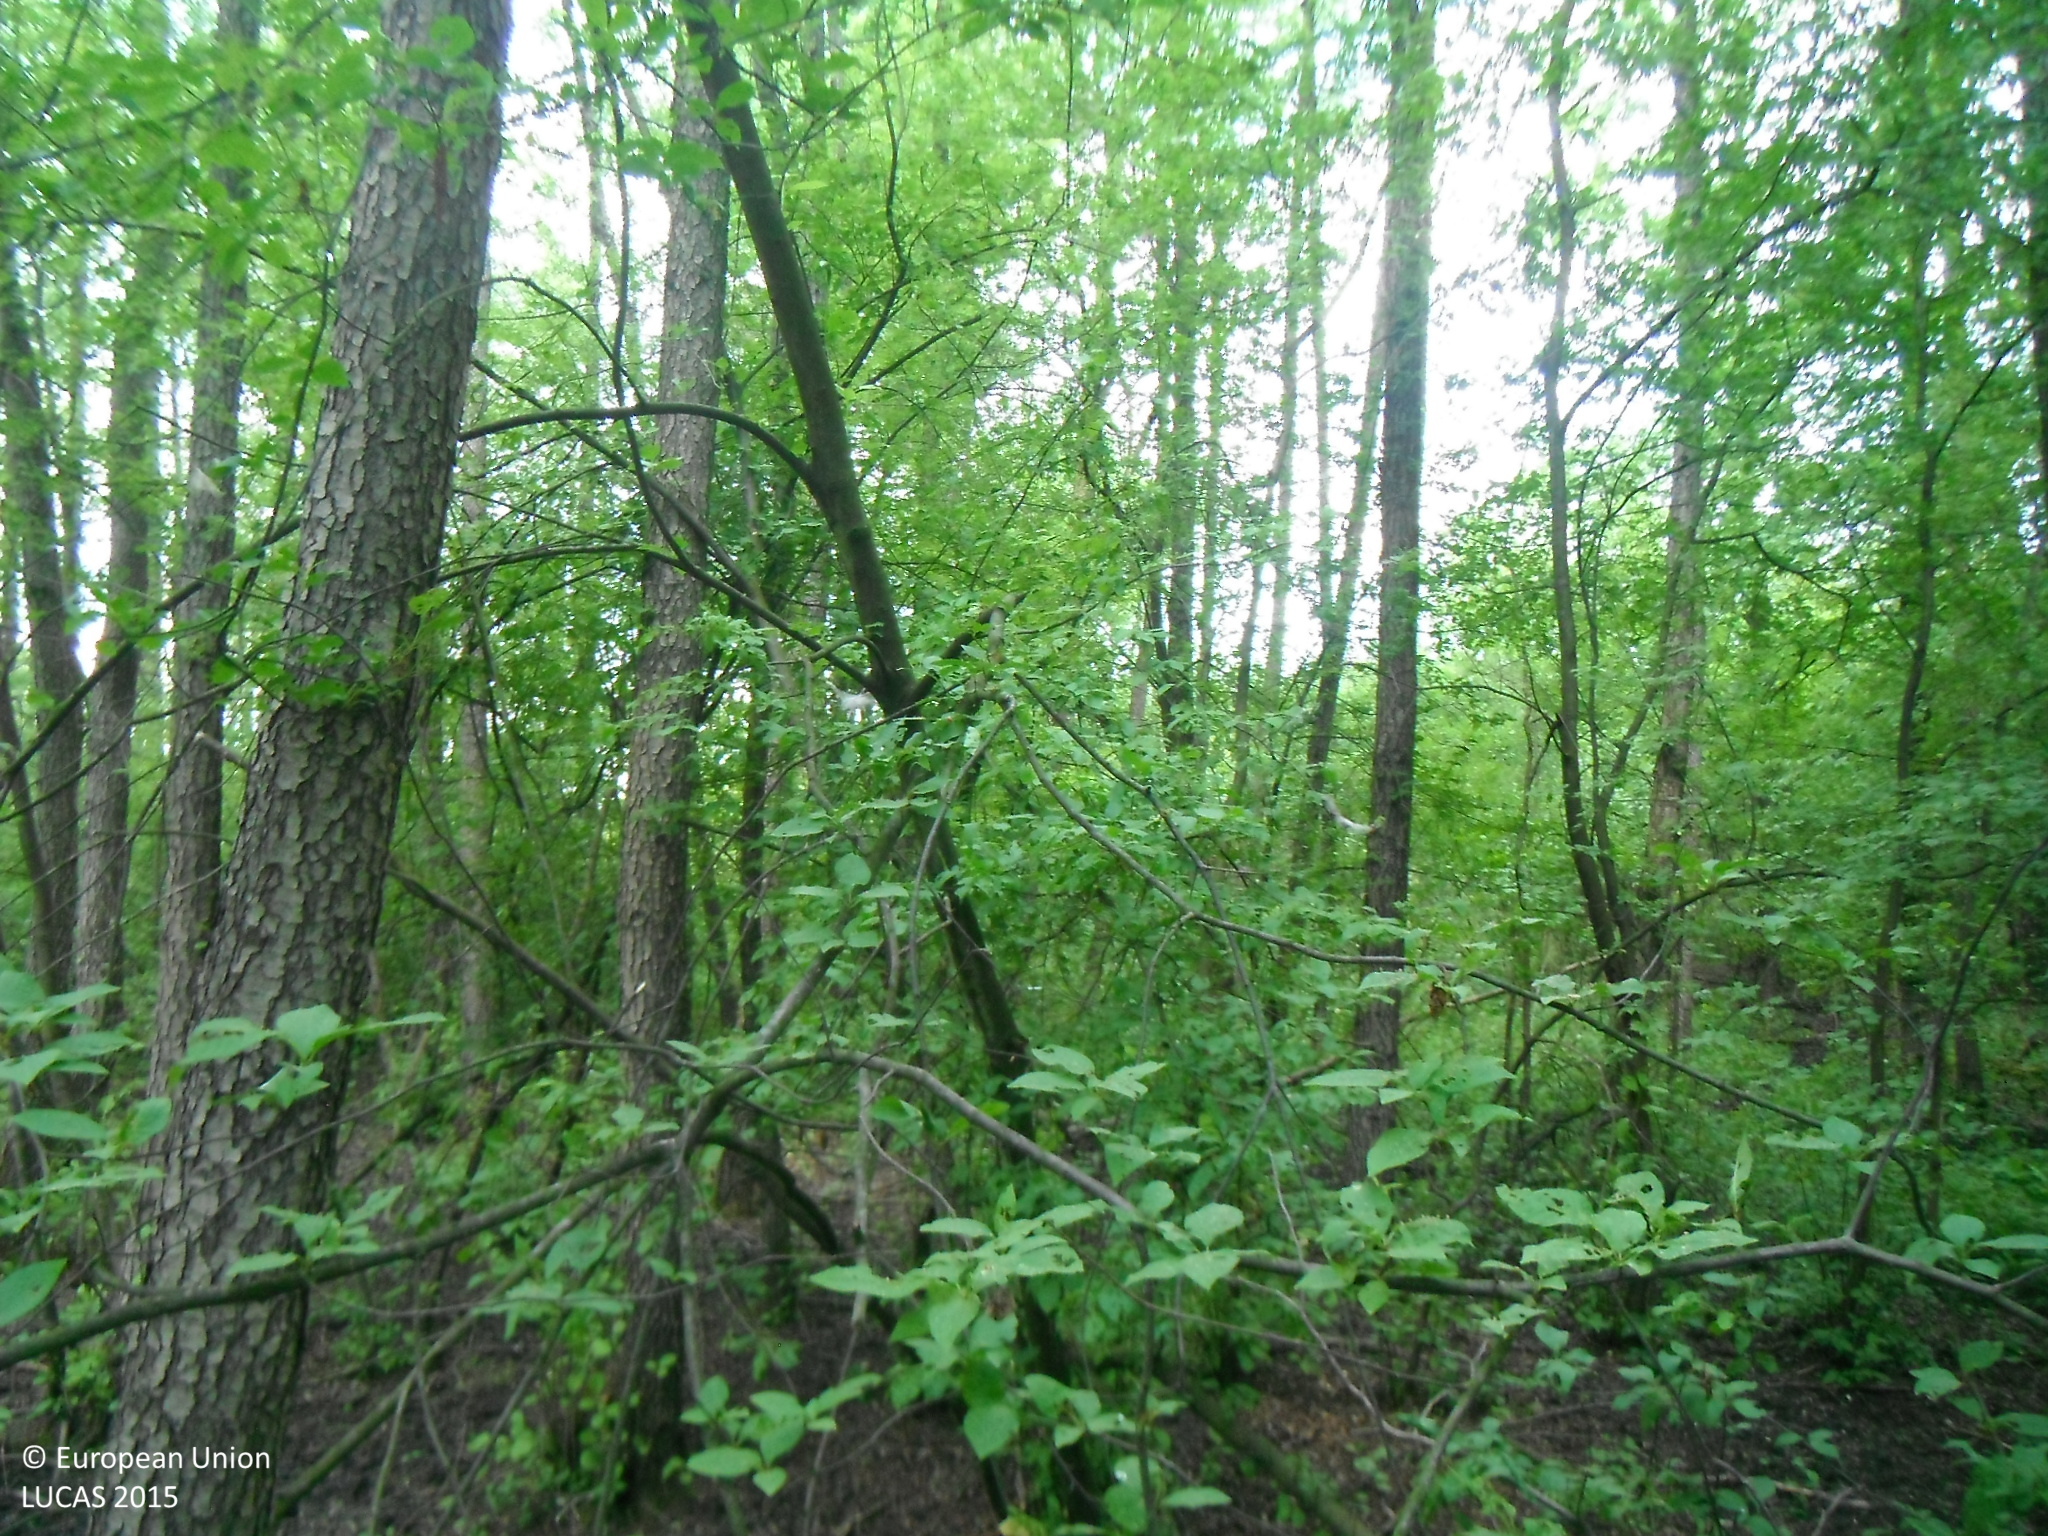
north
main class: Woodland
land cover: Broadleaved woodland
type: mesophytic deciduous forest
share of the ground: > 75 %
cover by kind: broadleaved forest trees 90 %, shrubs 10 %
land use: Forestry
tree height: > 5 m
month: May
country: SK
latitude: 48.5744
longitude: 17.0700
